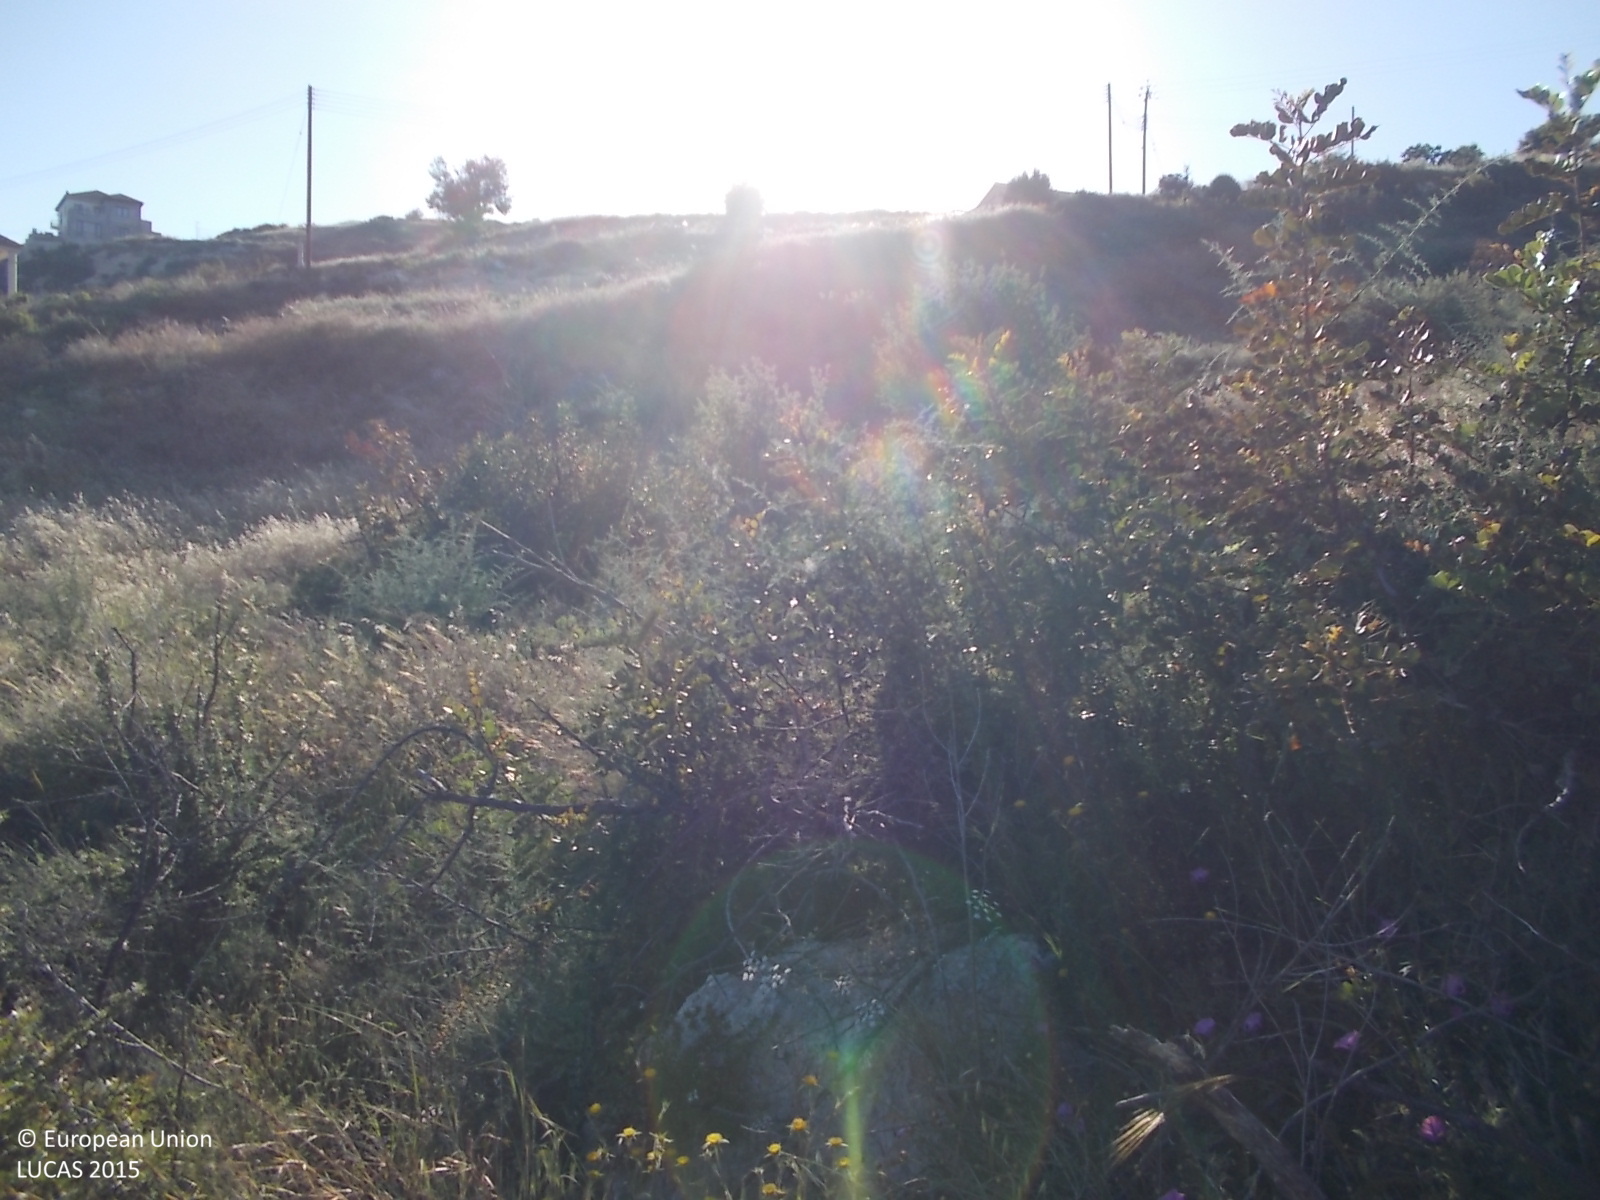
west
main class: Shrubland
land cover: Shrubland without tree cover
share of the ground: 50 - 75 %
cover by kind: shrubs 60 %, herbaceous plants 35 %, consolidated bare surface 5 %
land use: Semi-natural and natural areas not in use
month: April
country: CY
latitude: 34.7555
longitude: 33.0770
